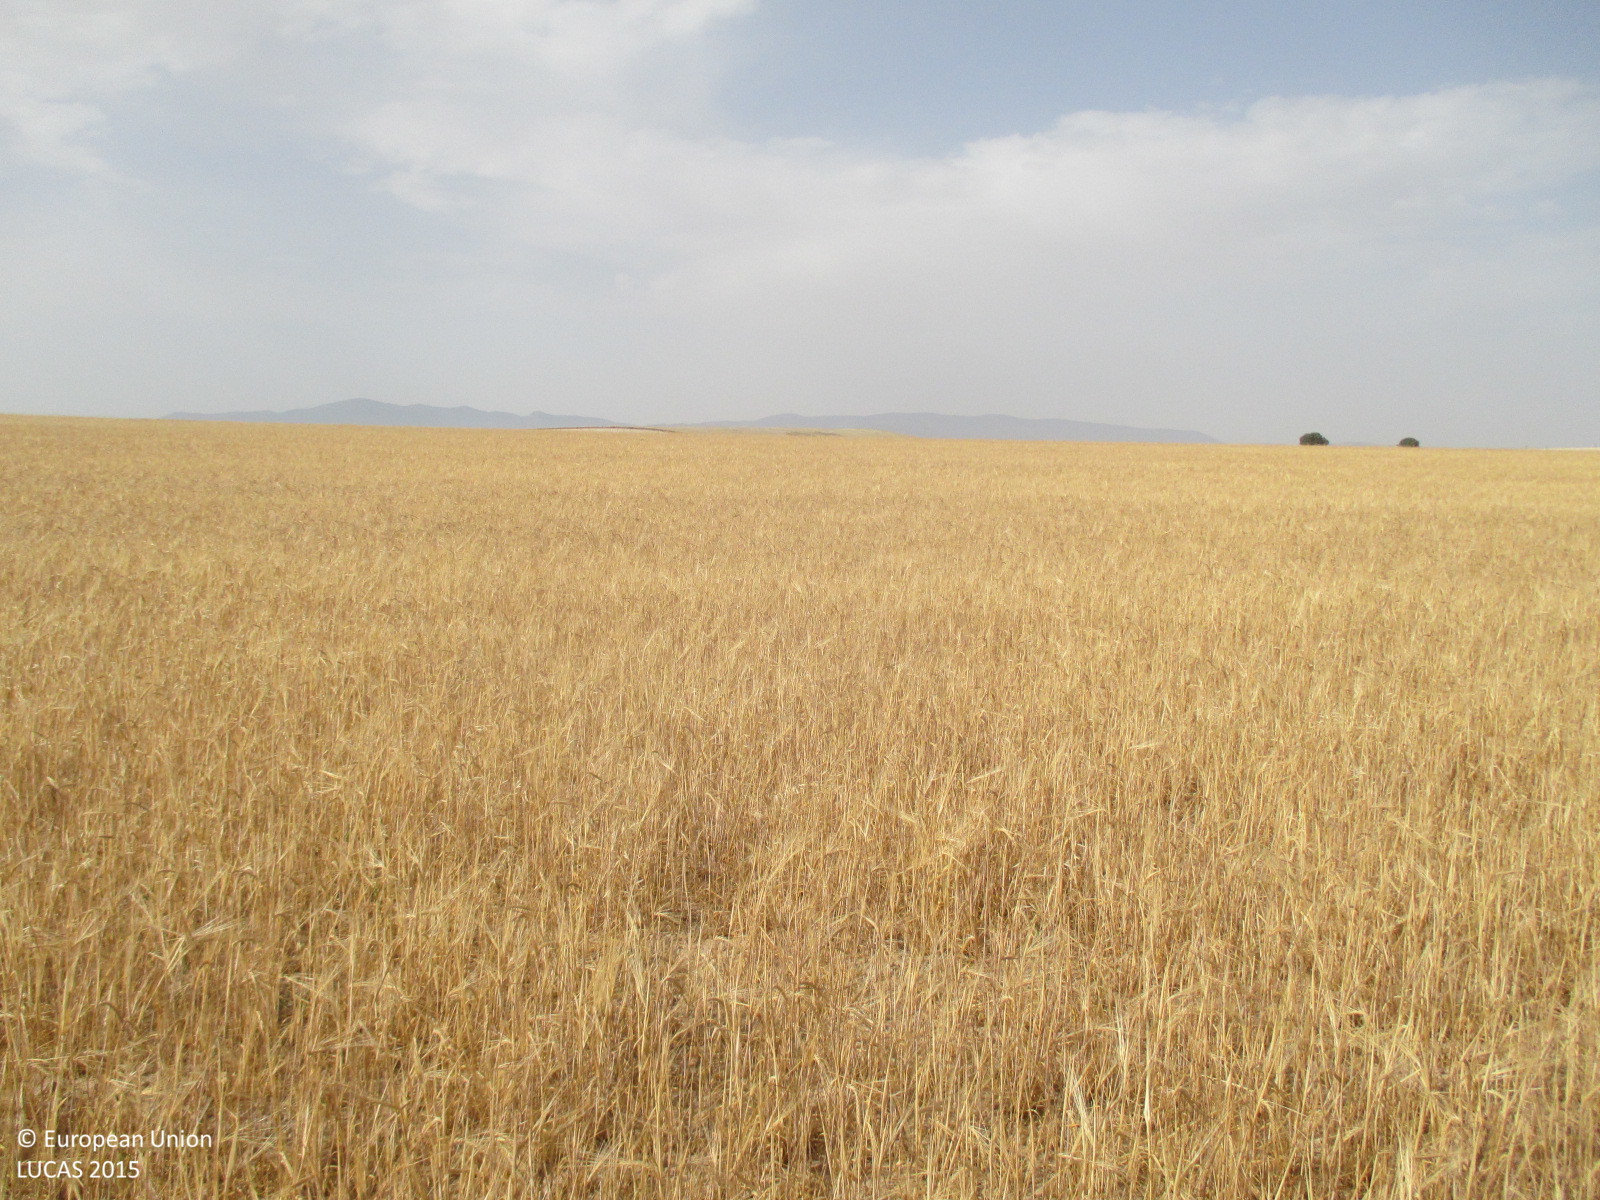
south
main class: Cropland
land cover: Barley
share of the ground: 50 - 75 %
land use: Agriculture (excluding fallow land and kitchen gardens)
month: July
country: ES
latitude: 37.7936
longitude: -2.4010
